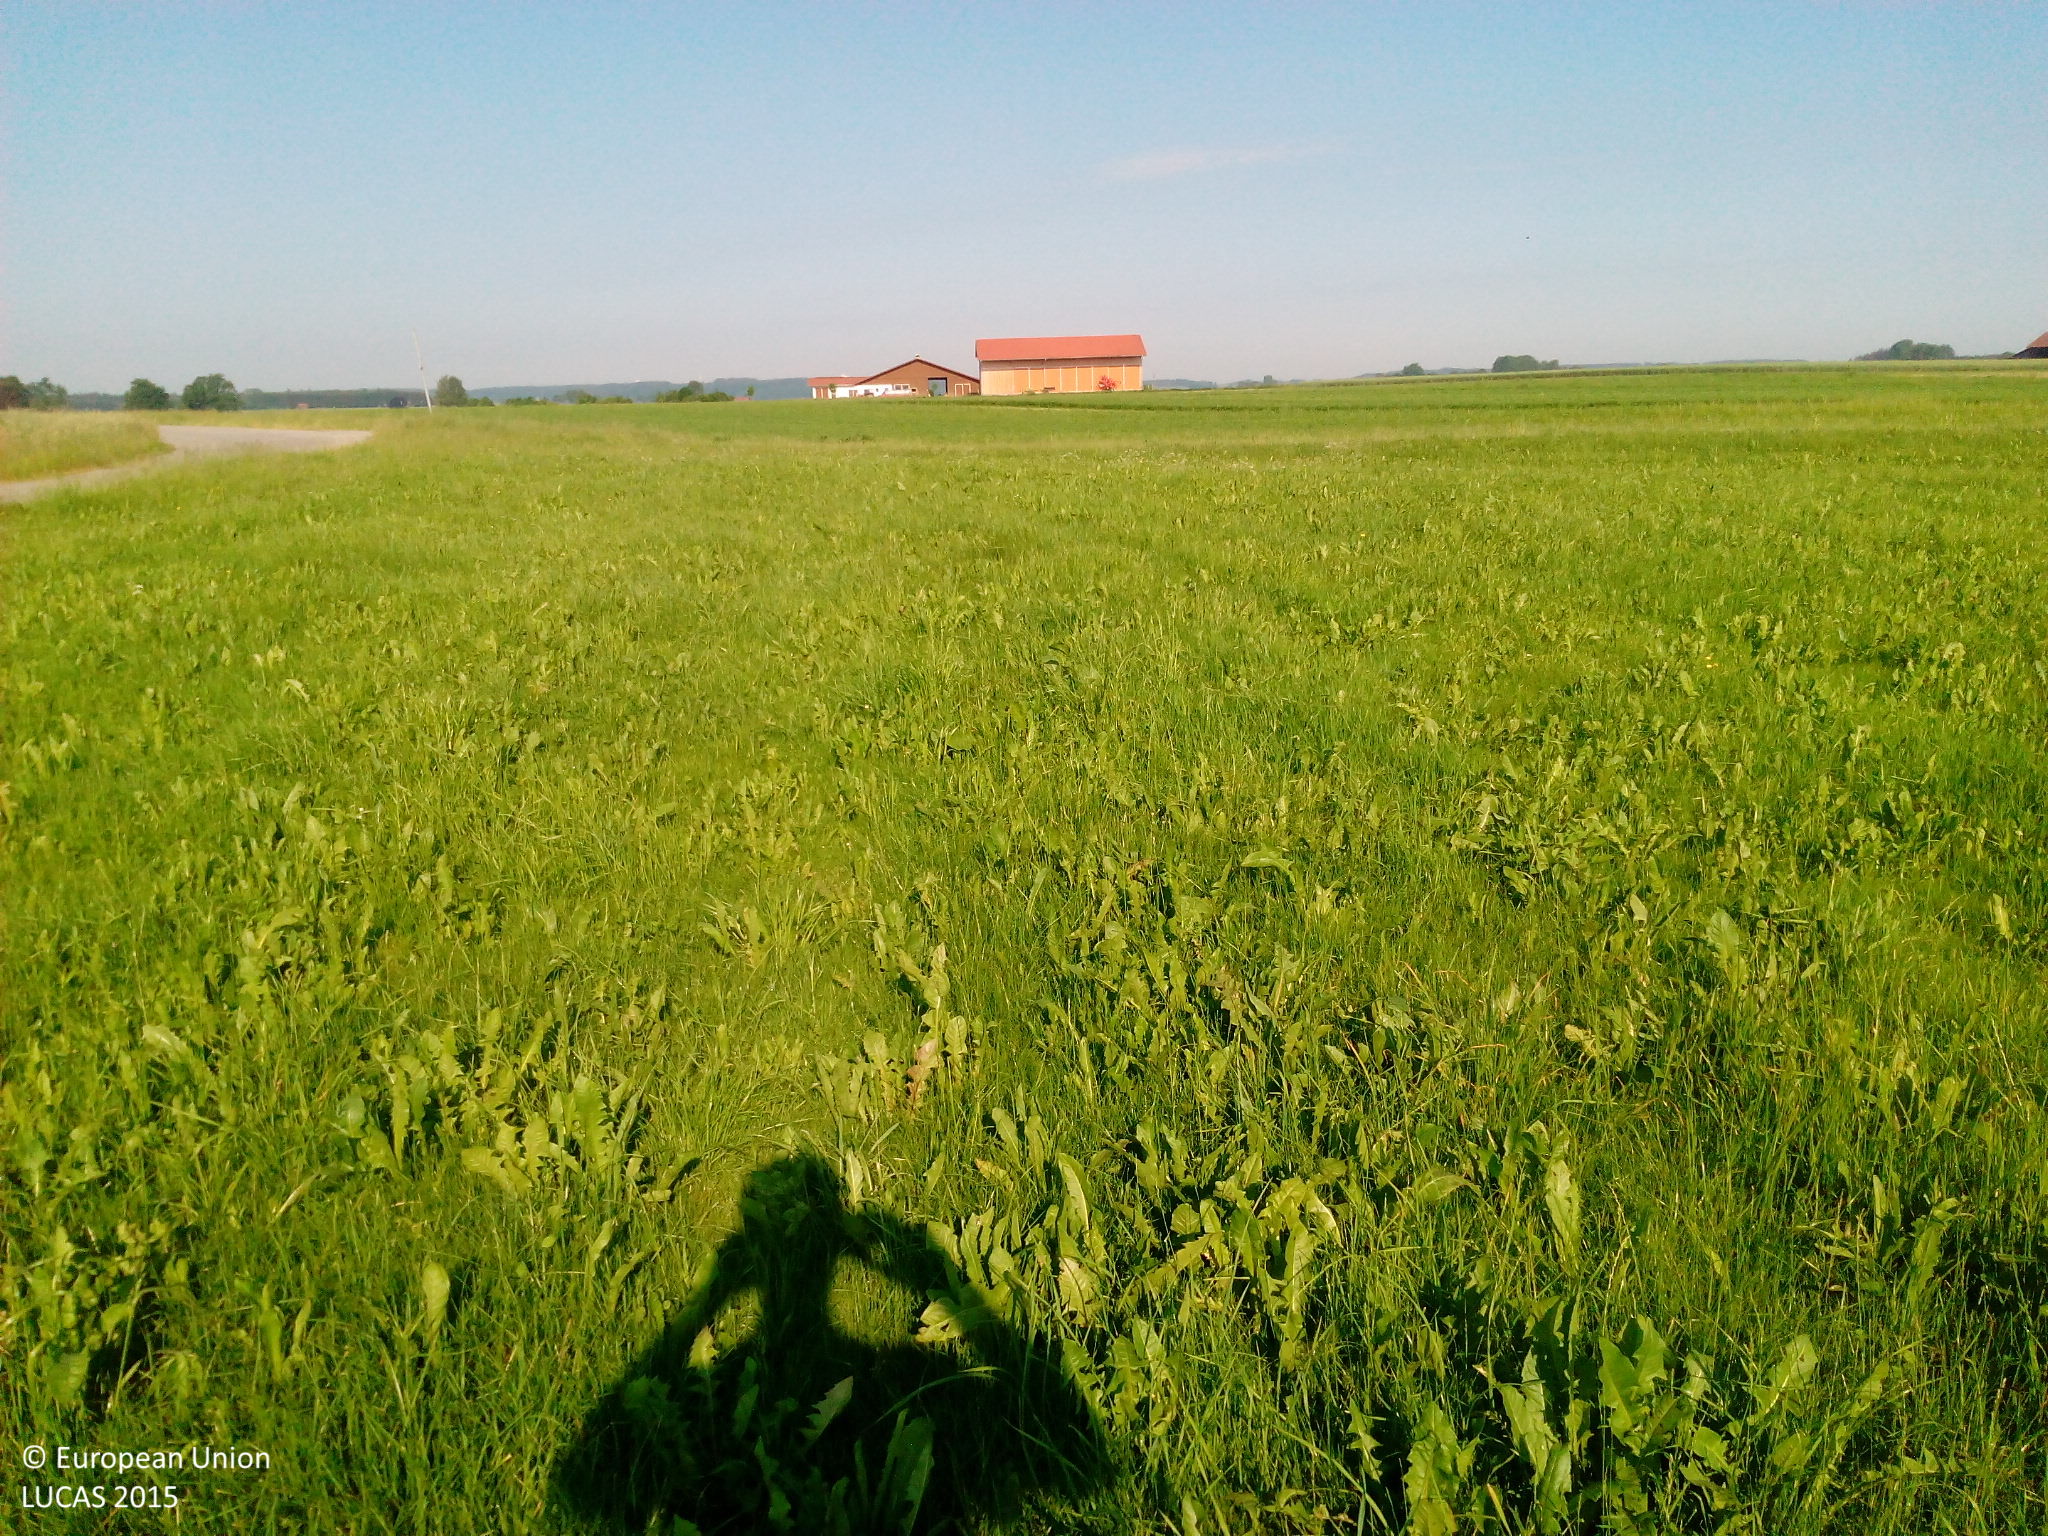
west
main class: Grassland
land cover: Grassland without tree/shrub cover
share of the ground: > 75 %
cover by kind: herbaceous plants 100 %
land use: Agriculture (excluding fallow land and kitchen gardens)
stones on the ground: < 10 %
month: June
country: DE
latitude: 47.9519
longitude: 10.6021
